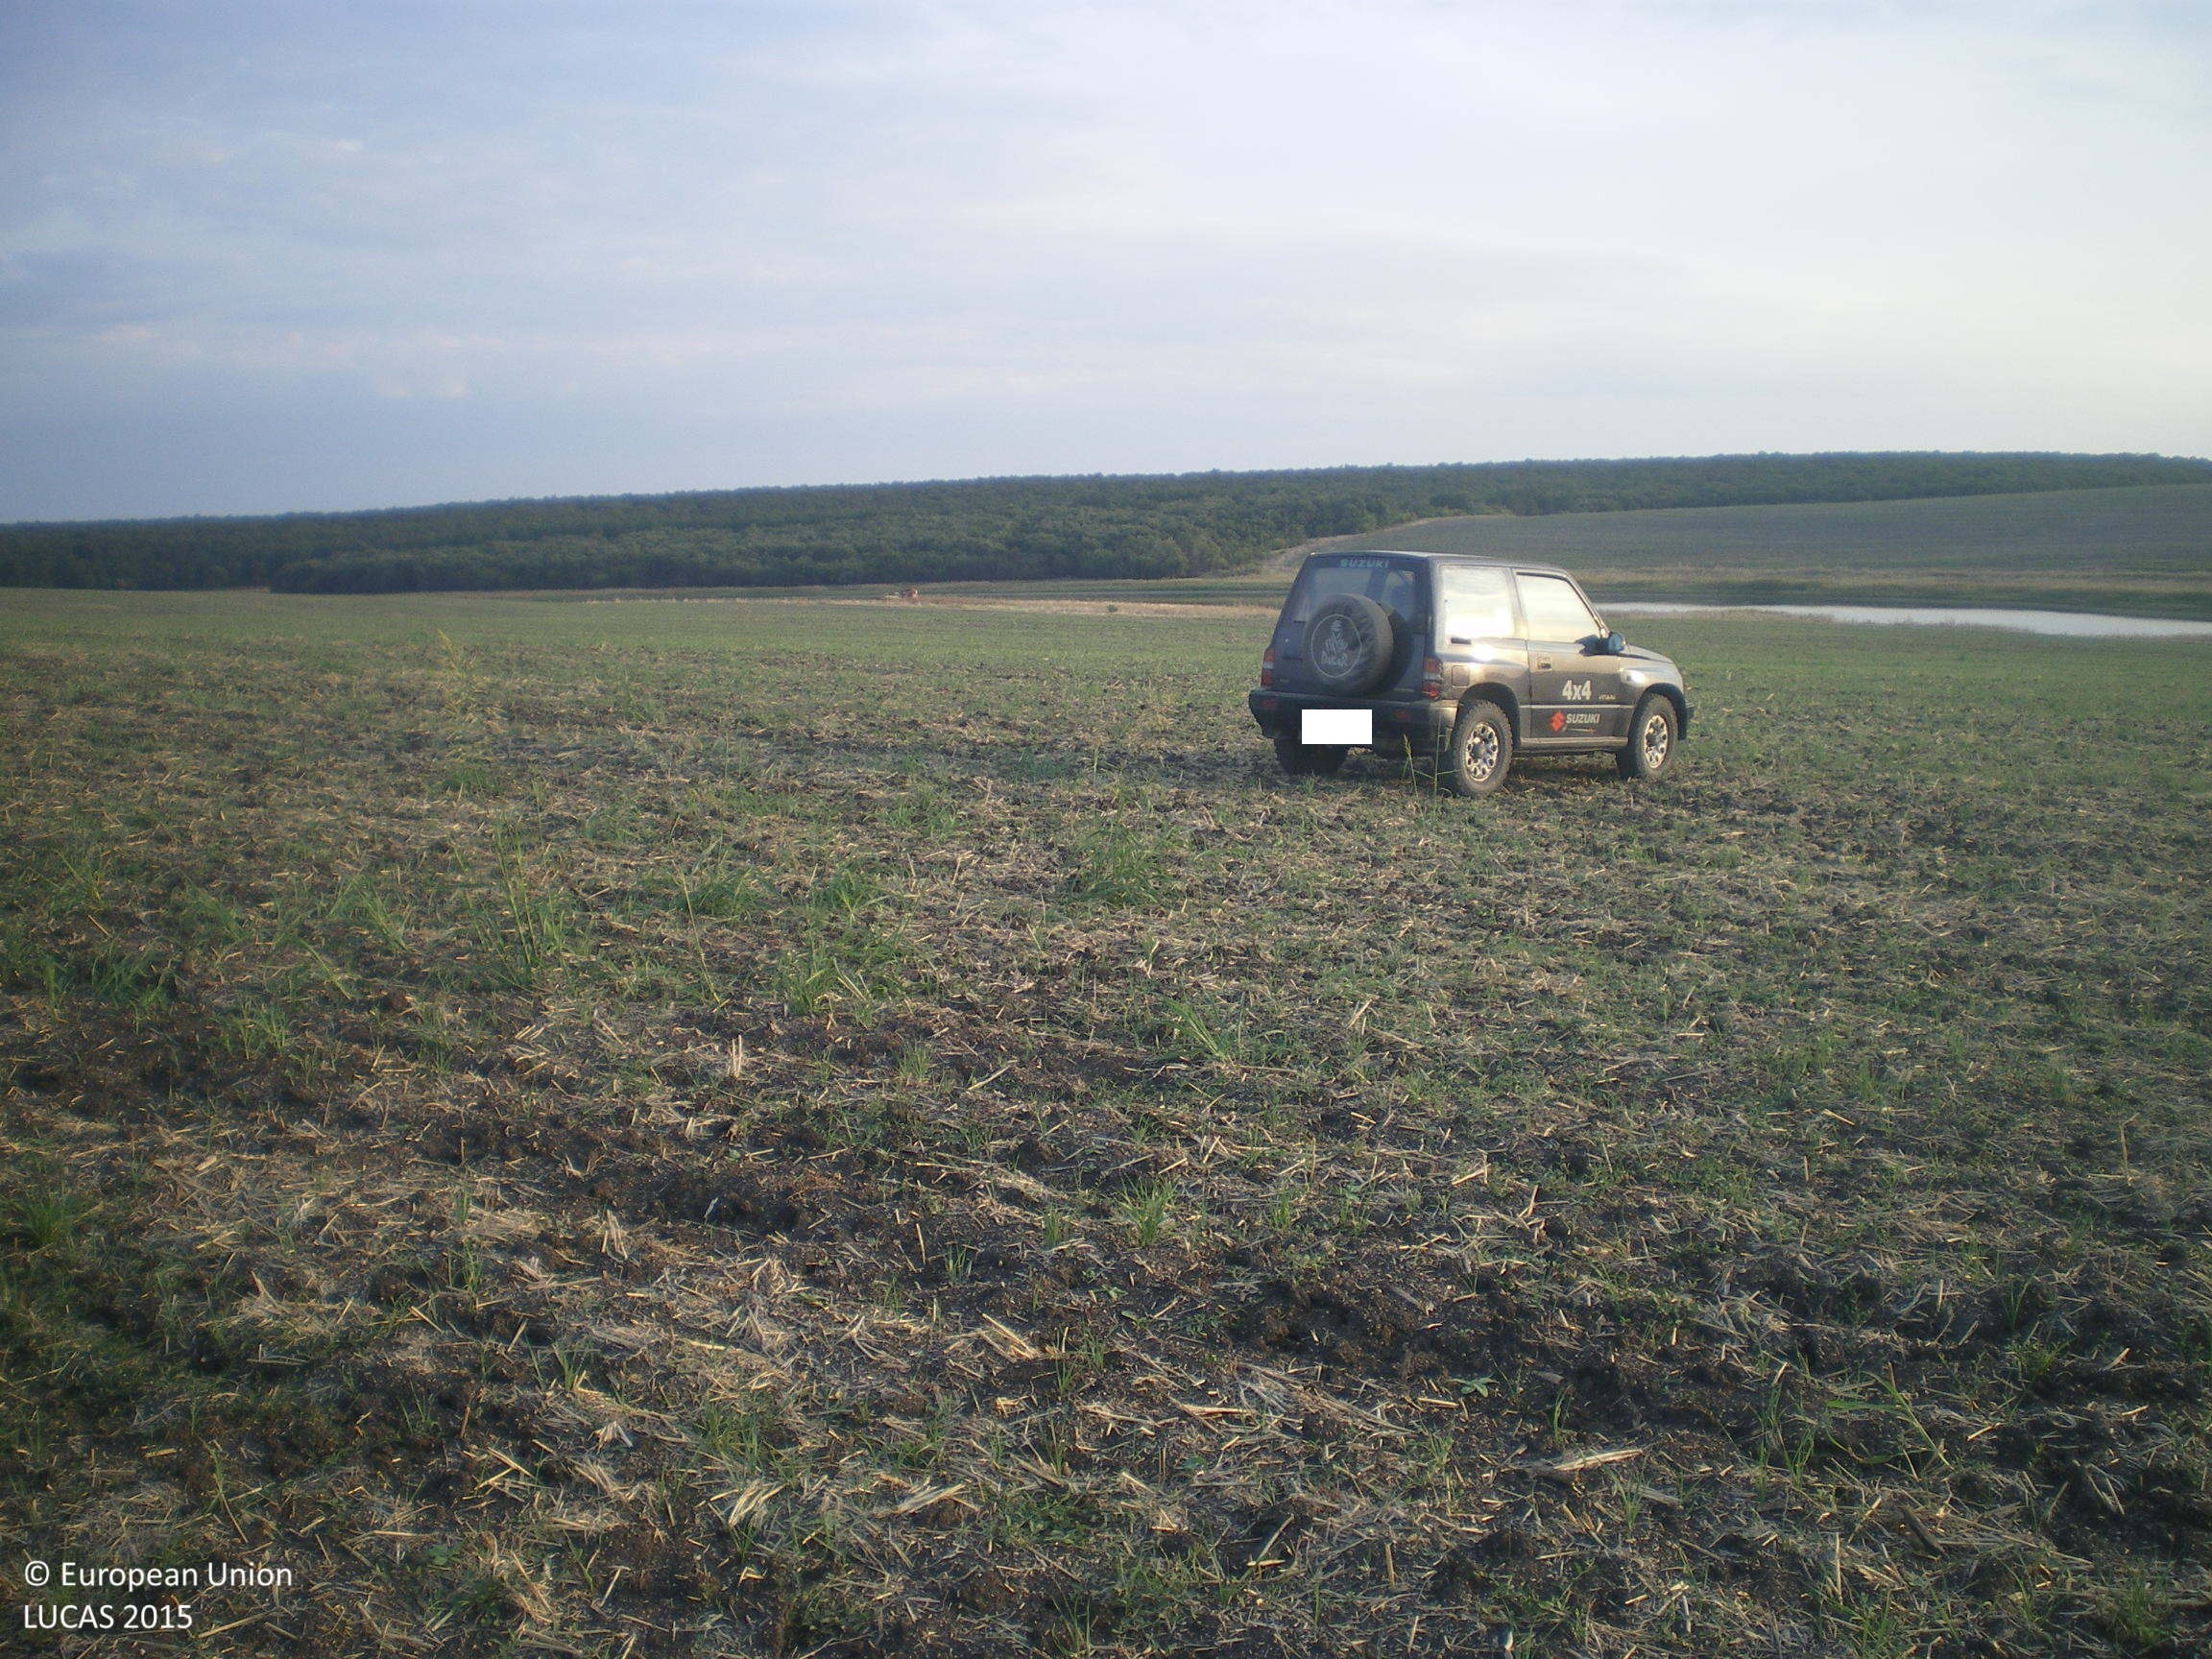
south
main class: Cropland
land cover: Common wheat
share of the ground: < 10 %
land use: Agriculture (excluding fallow land and kitchen gardens)
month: September
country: BG
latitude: 42.1588
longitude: 25.7938
